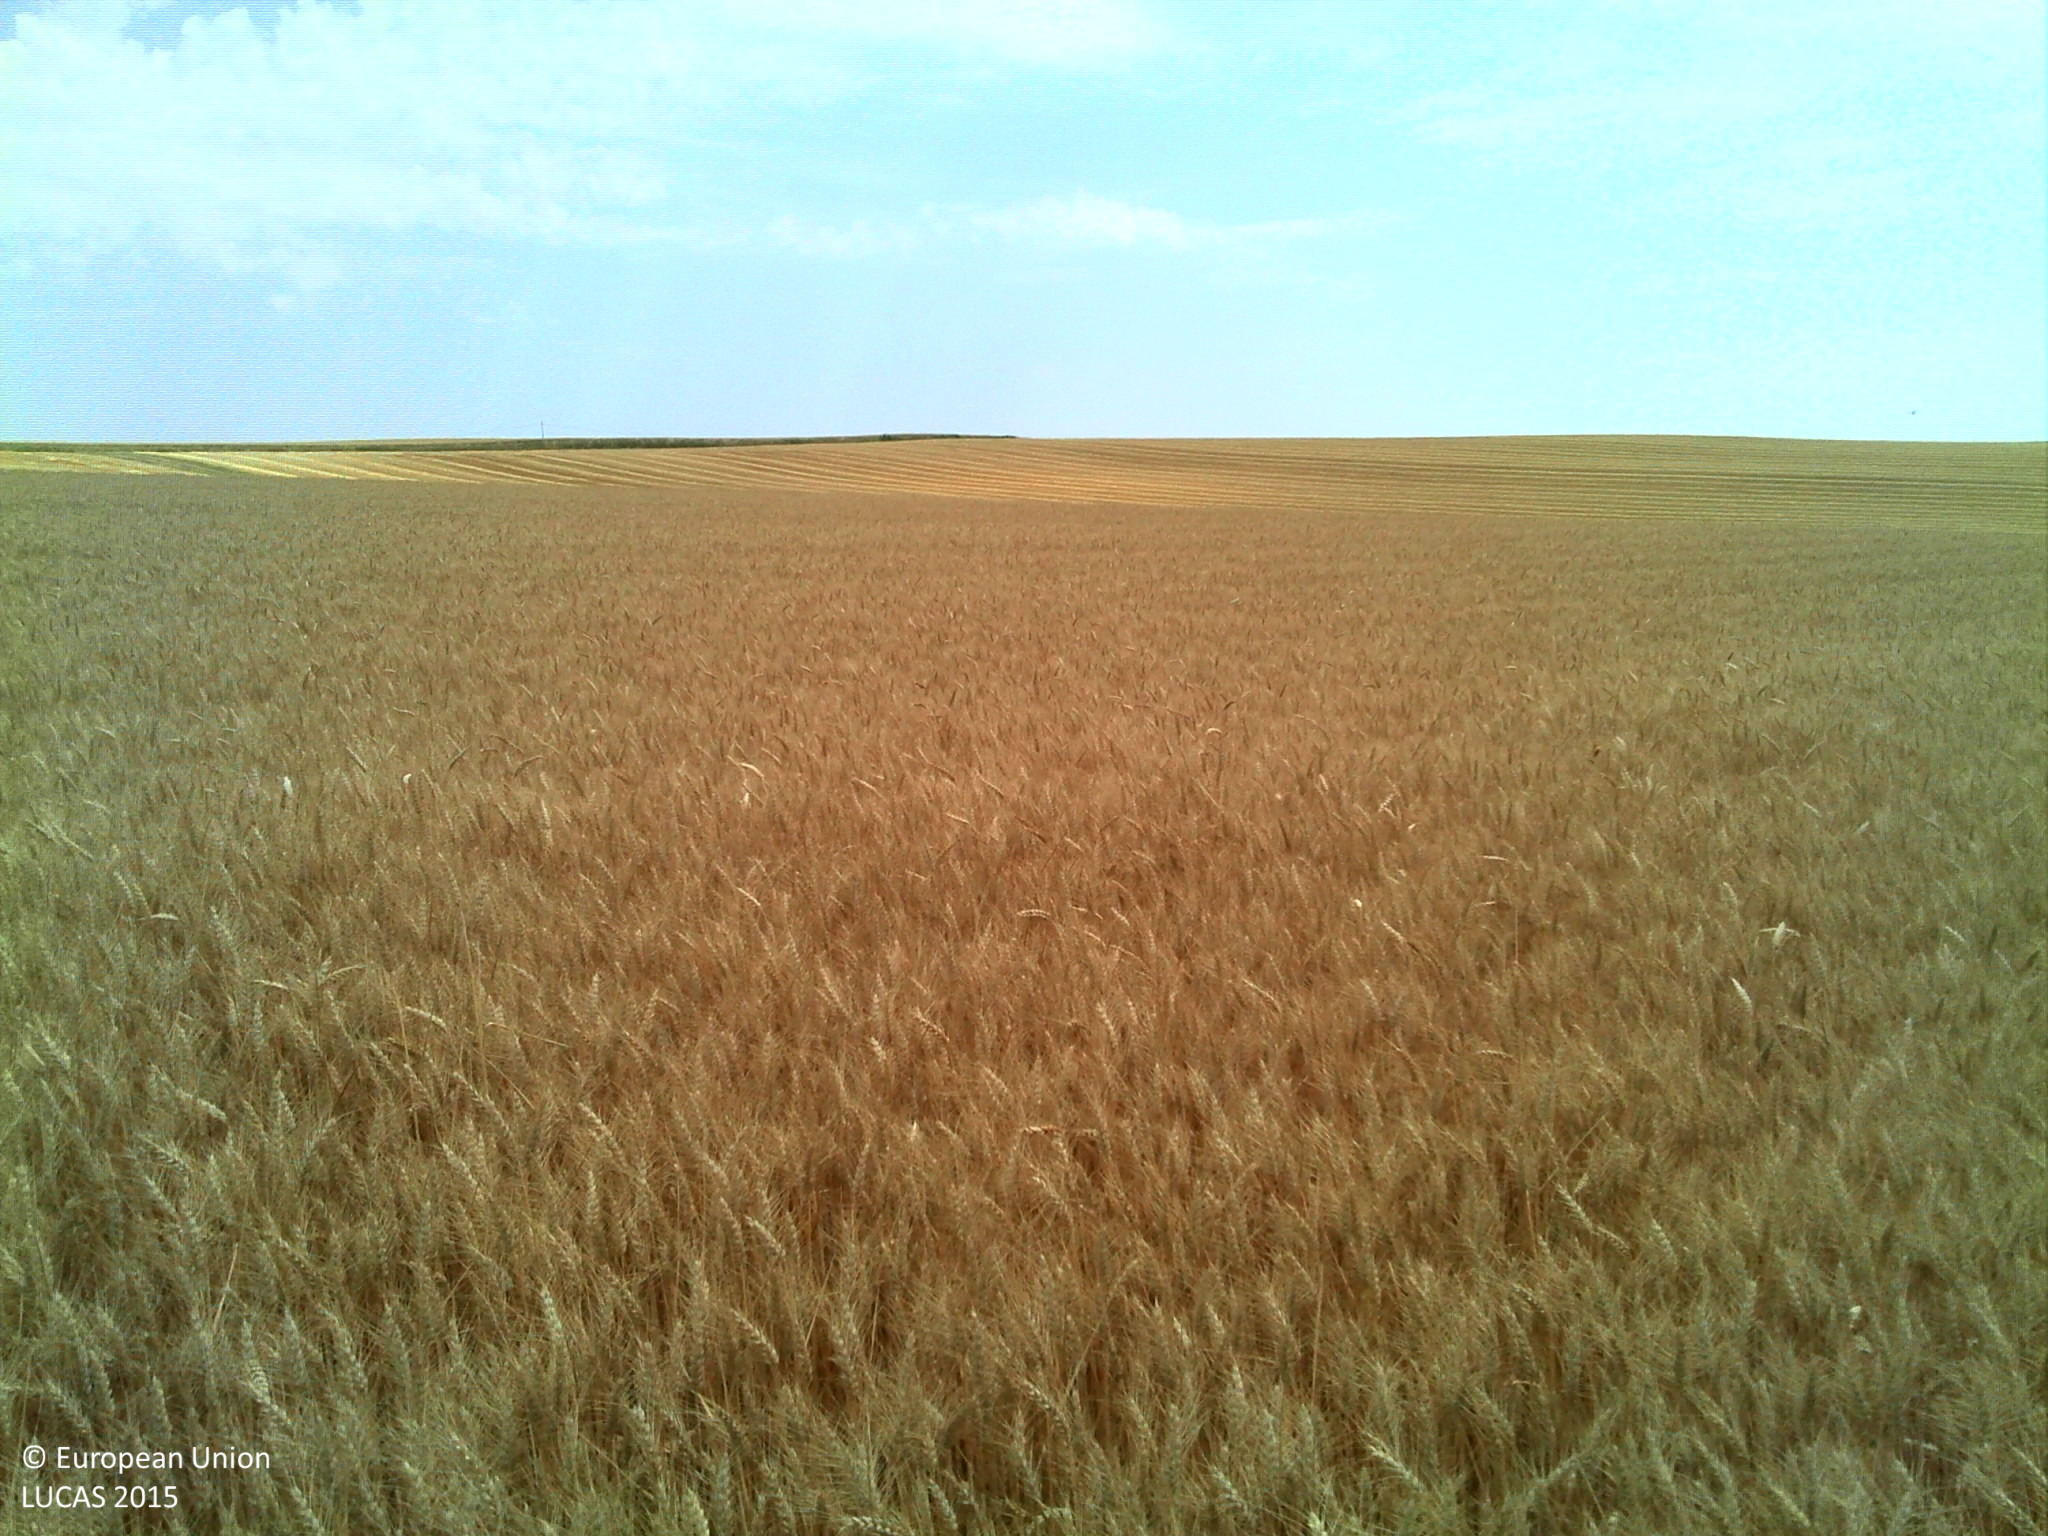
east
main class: Cropland
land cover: Durum wheat
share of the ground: > 75 %
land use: Agriculture (excluding fallow land and kitchen gardens)
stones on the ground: 10 - 25 %
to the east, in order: Durum wheat; Common wheat; Tracks; Barley
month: July
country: FR
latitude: 47.2932
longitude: 3.5305
